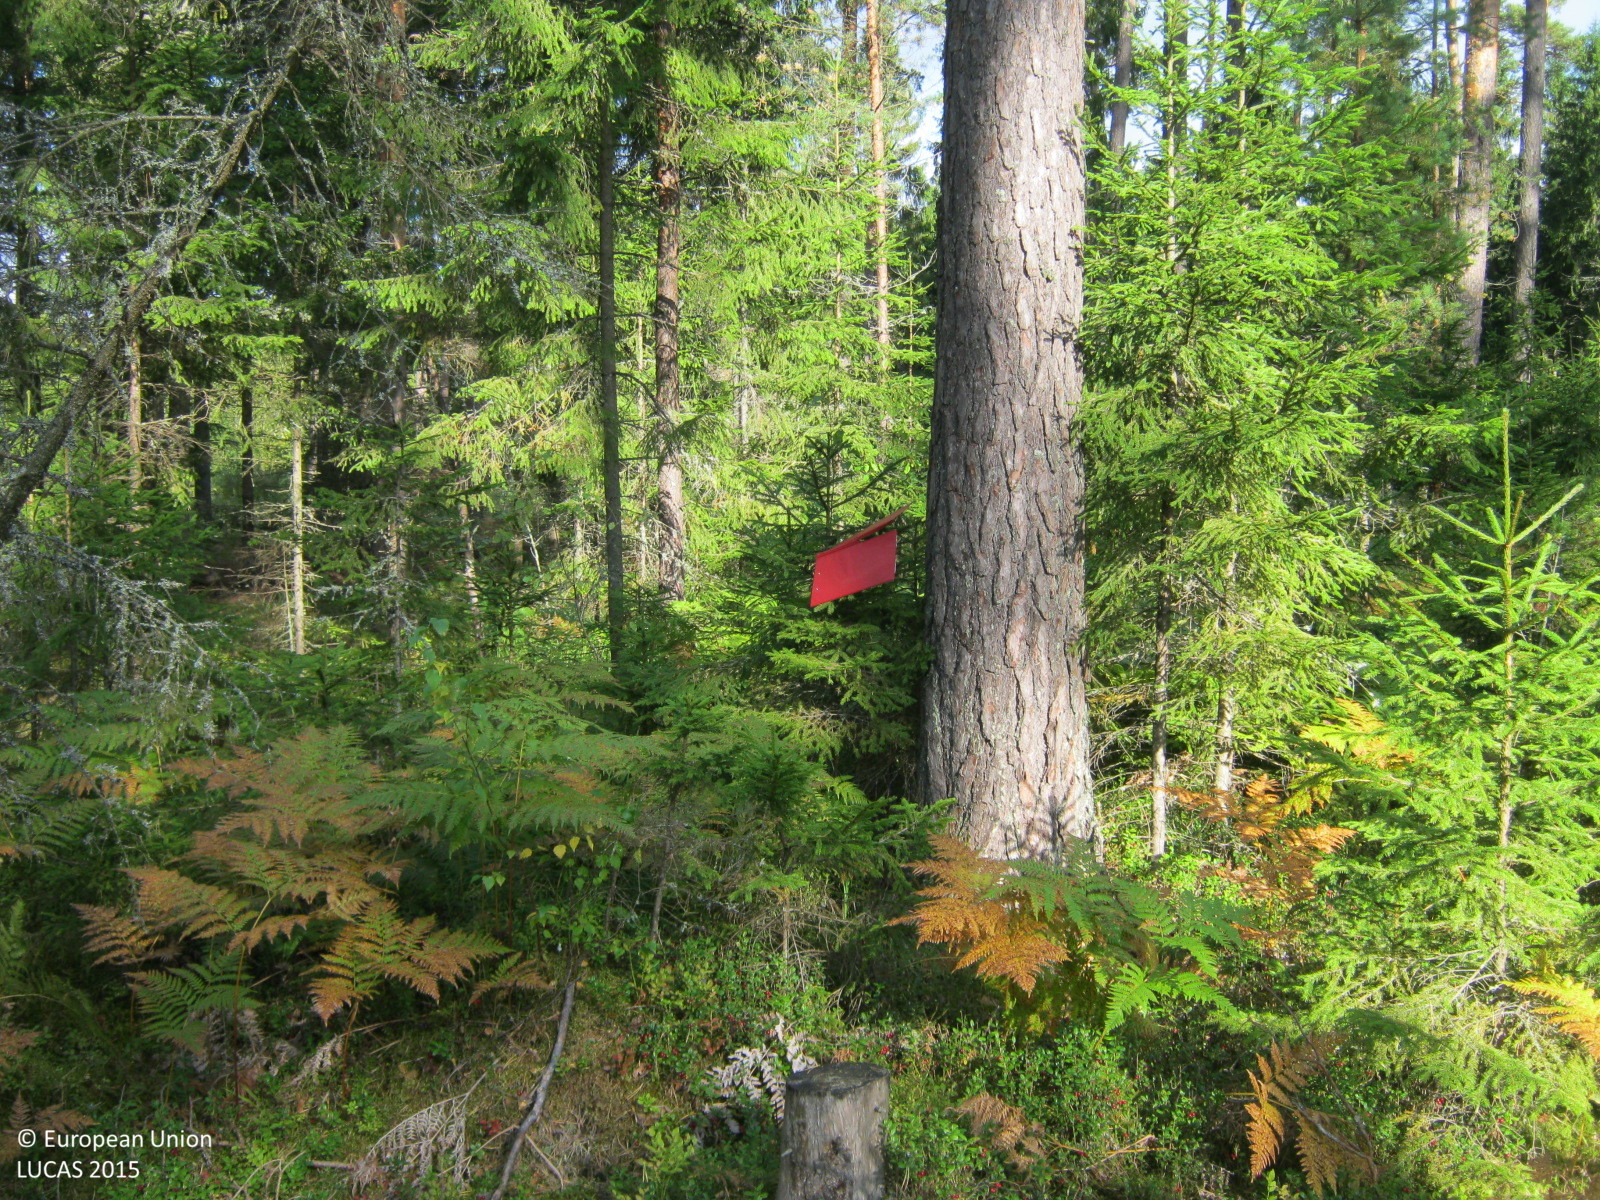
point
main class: Woodland
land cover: Other coniferous woodland
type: hemiboreal forest and nemoral coniferous forest and mixed broadleaved-coniferous forest
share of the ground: > 75 %
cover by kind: coniferous forest trees 80 %, shrubs 10 %, lichens and mosses 10 %
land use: Forestry
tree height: > 5 m
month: September
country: LV
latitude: 57.3045
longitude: 24.4487
